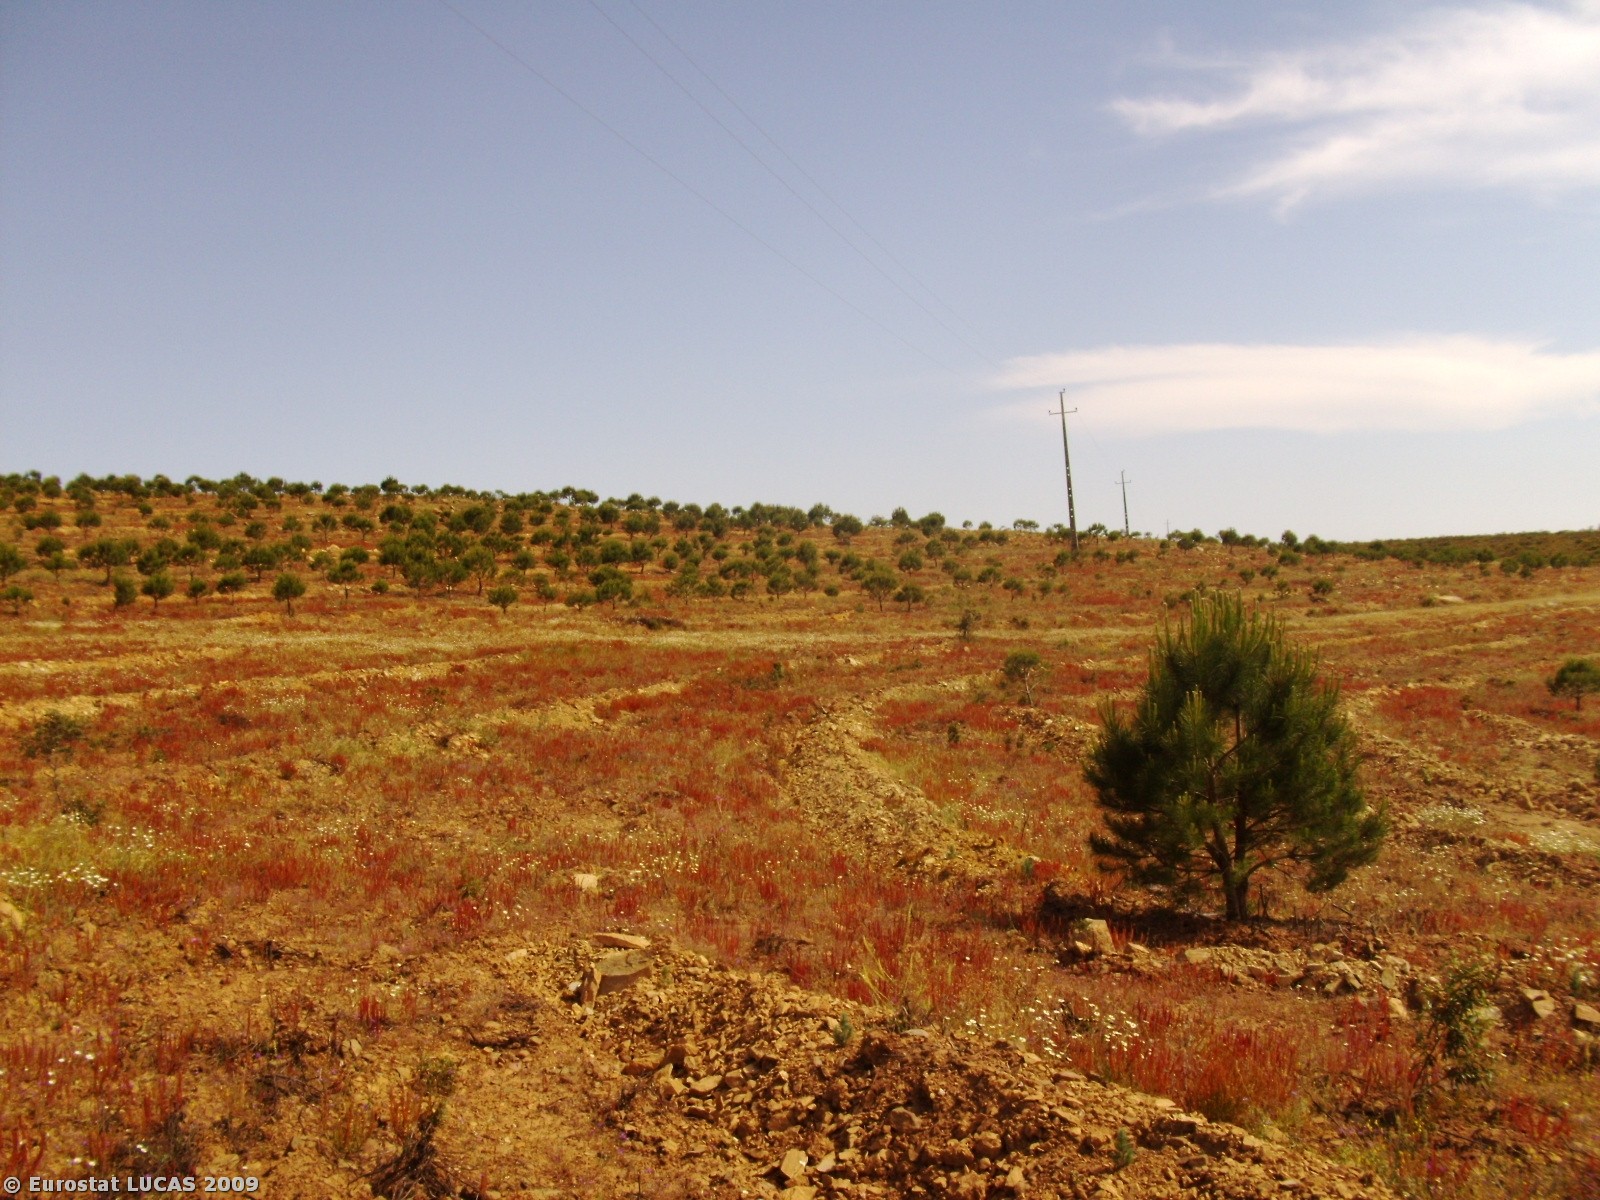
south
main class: Woodland
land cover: Coniferous woodland
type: coniferous forest of the mediterranean region
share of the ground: 10 - 25 %
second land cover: Bare land
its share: > 75 %
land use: Forestry
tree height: > 5 m
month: May
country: PT
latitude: 37.4543
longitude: -7.6352
